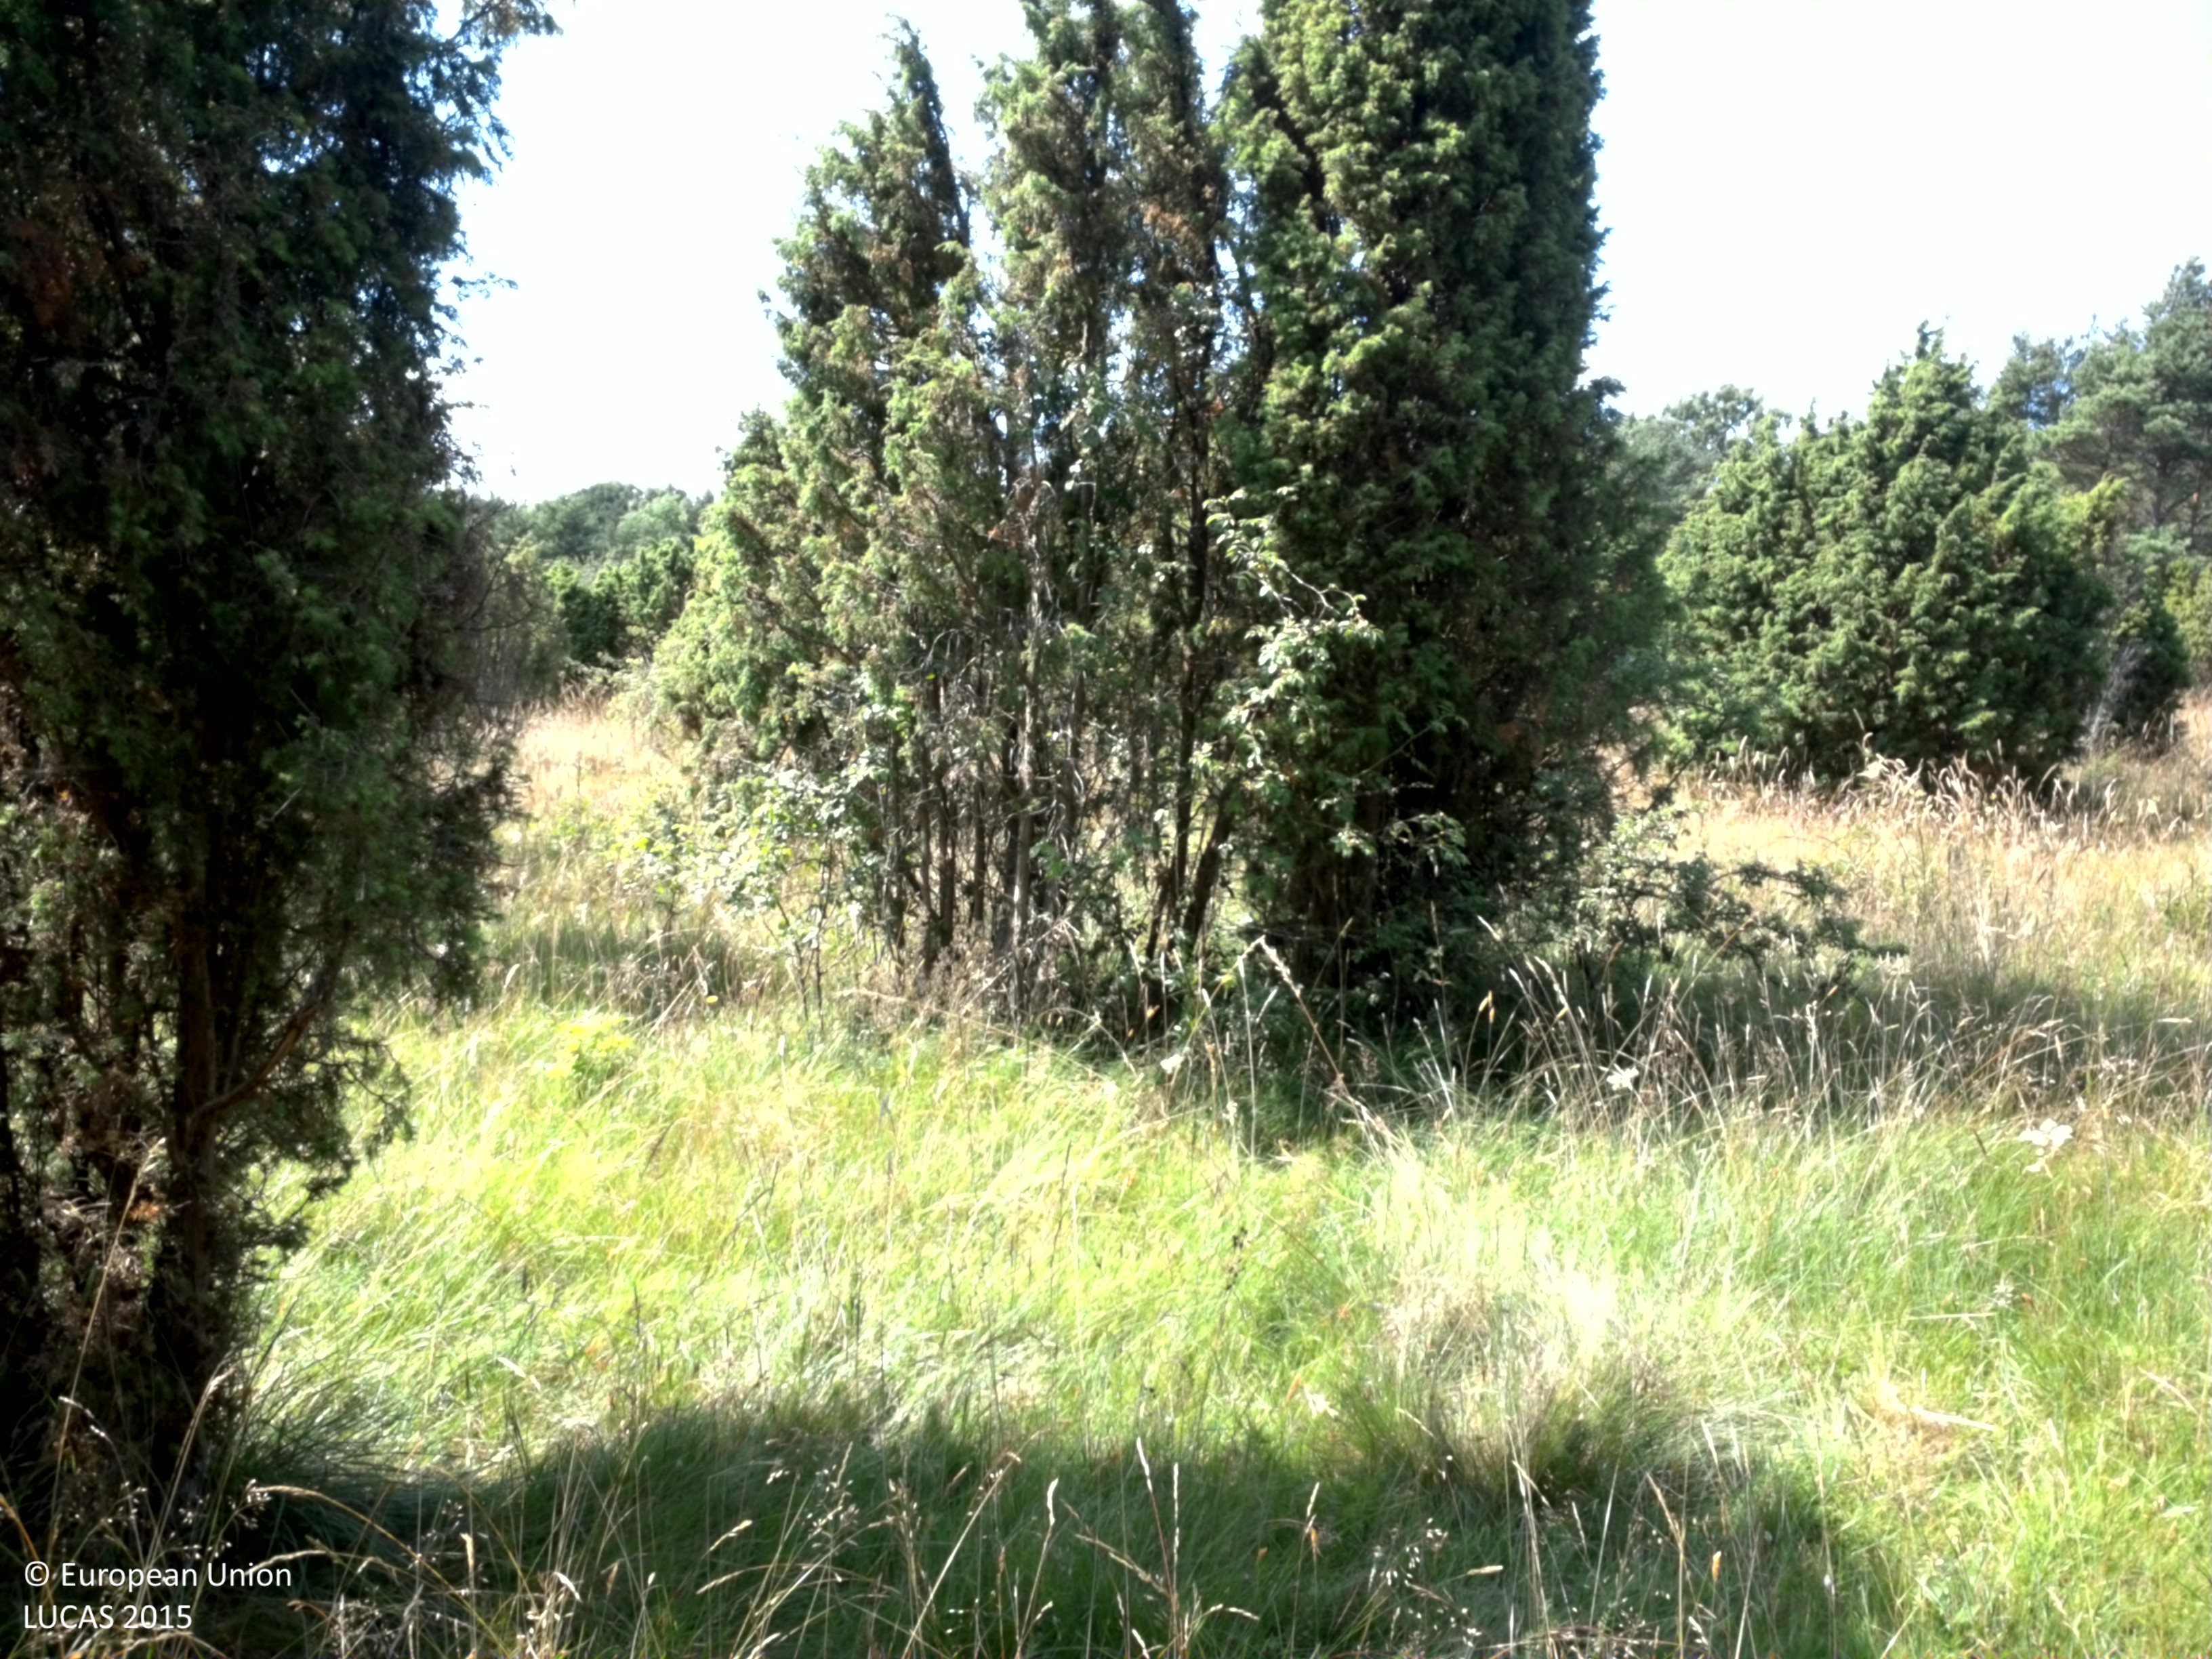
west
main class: Woodland
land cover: Pine dominated coniferous woodland
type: hemiboreal forest and nemoral coniferous forest and mixed broadleaved-coniferous forest
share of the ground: 50 - 75 %
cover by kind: coniferous forest trees 50 %, herbaceous plants 30 %, shrubs 20 %
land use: Amenities, museums, leisure
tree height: > 5 m
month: July
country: SE
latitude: 57.3219
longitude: 18.6958
